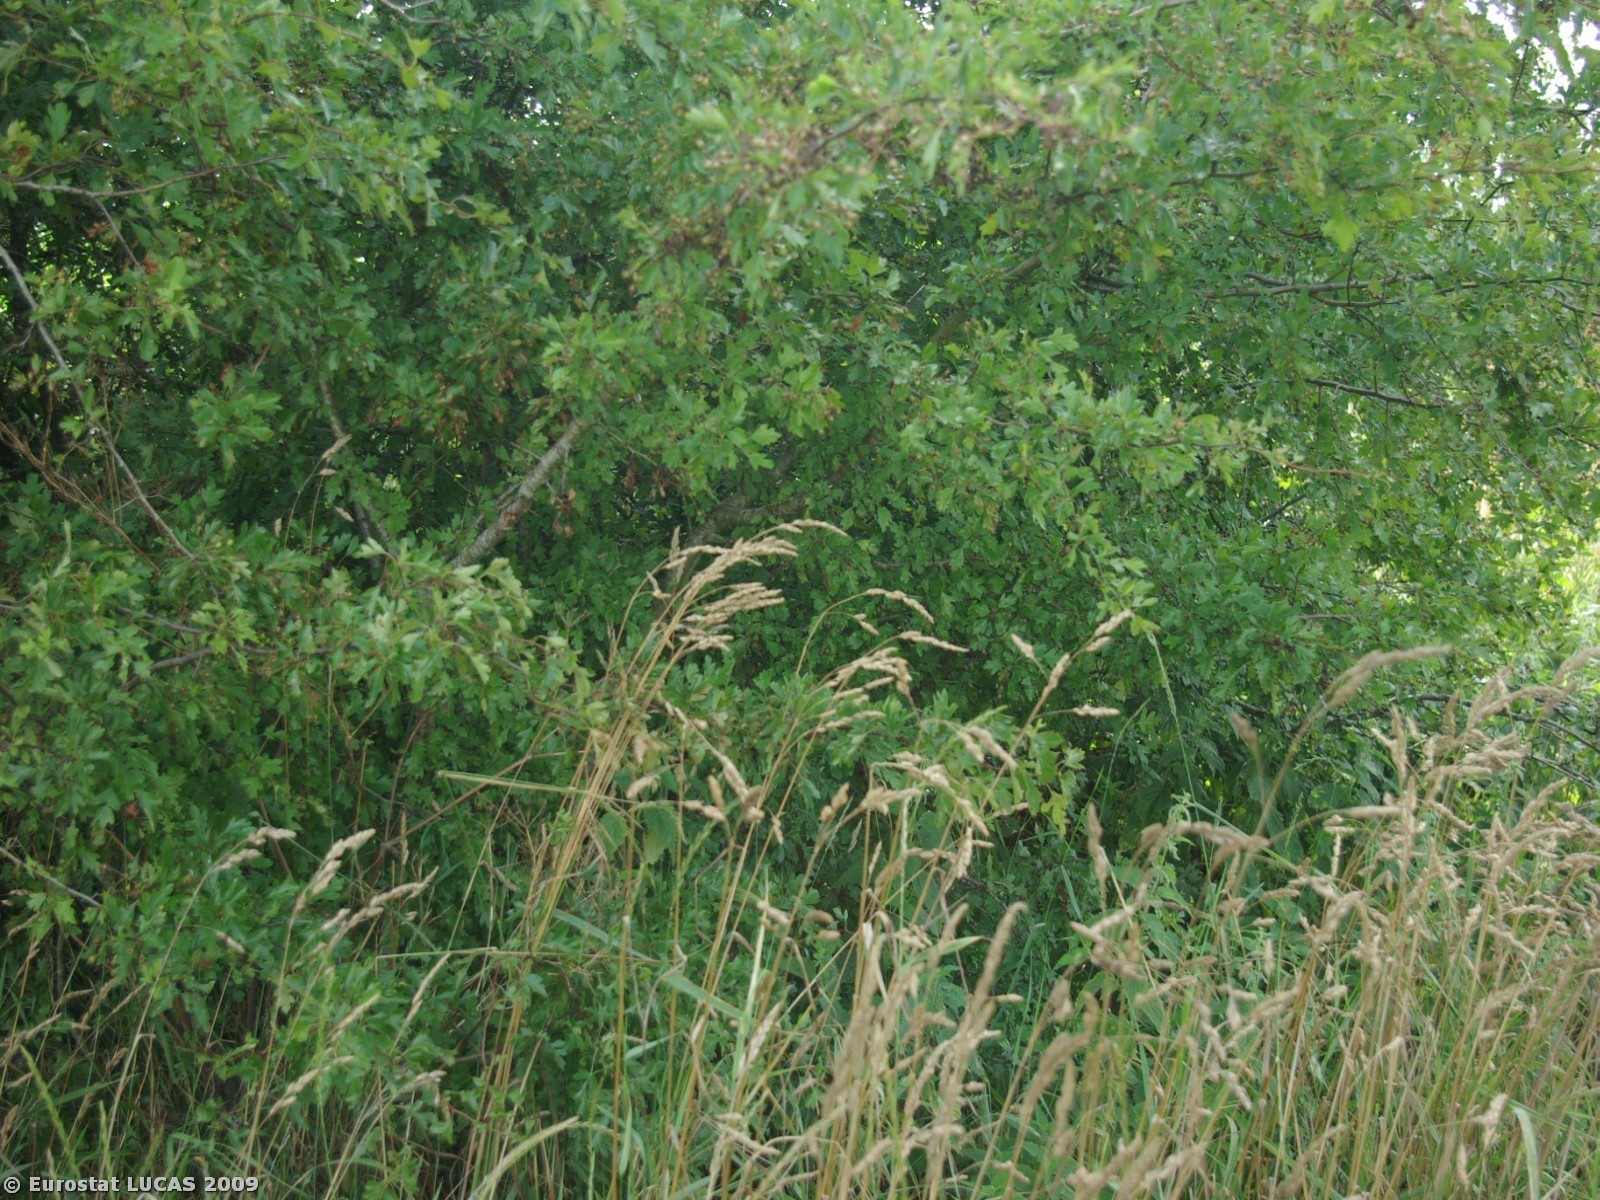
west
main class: Grassland
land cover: Grassland without tree/shrub cover
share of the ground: > 75 %
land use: Agriculture (excluding fallow land and kitchen gardens)
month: July
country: DK
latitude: 55.2119
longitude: 8.8537
